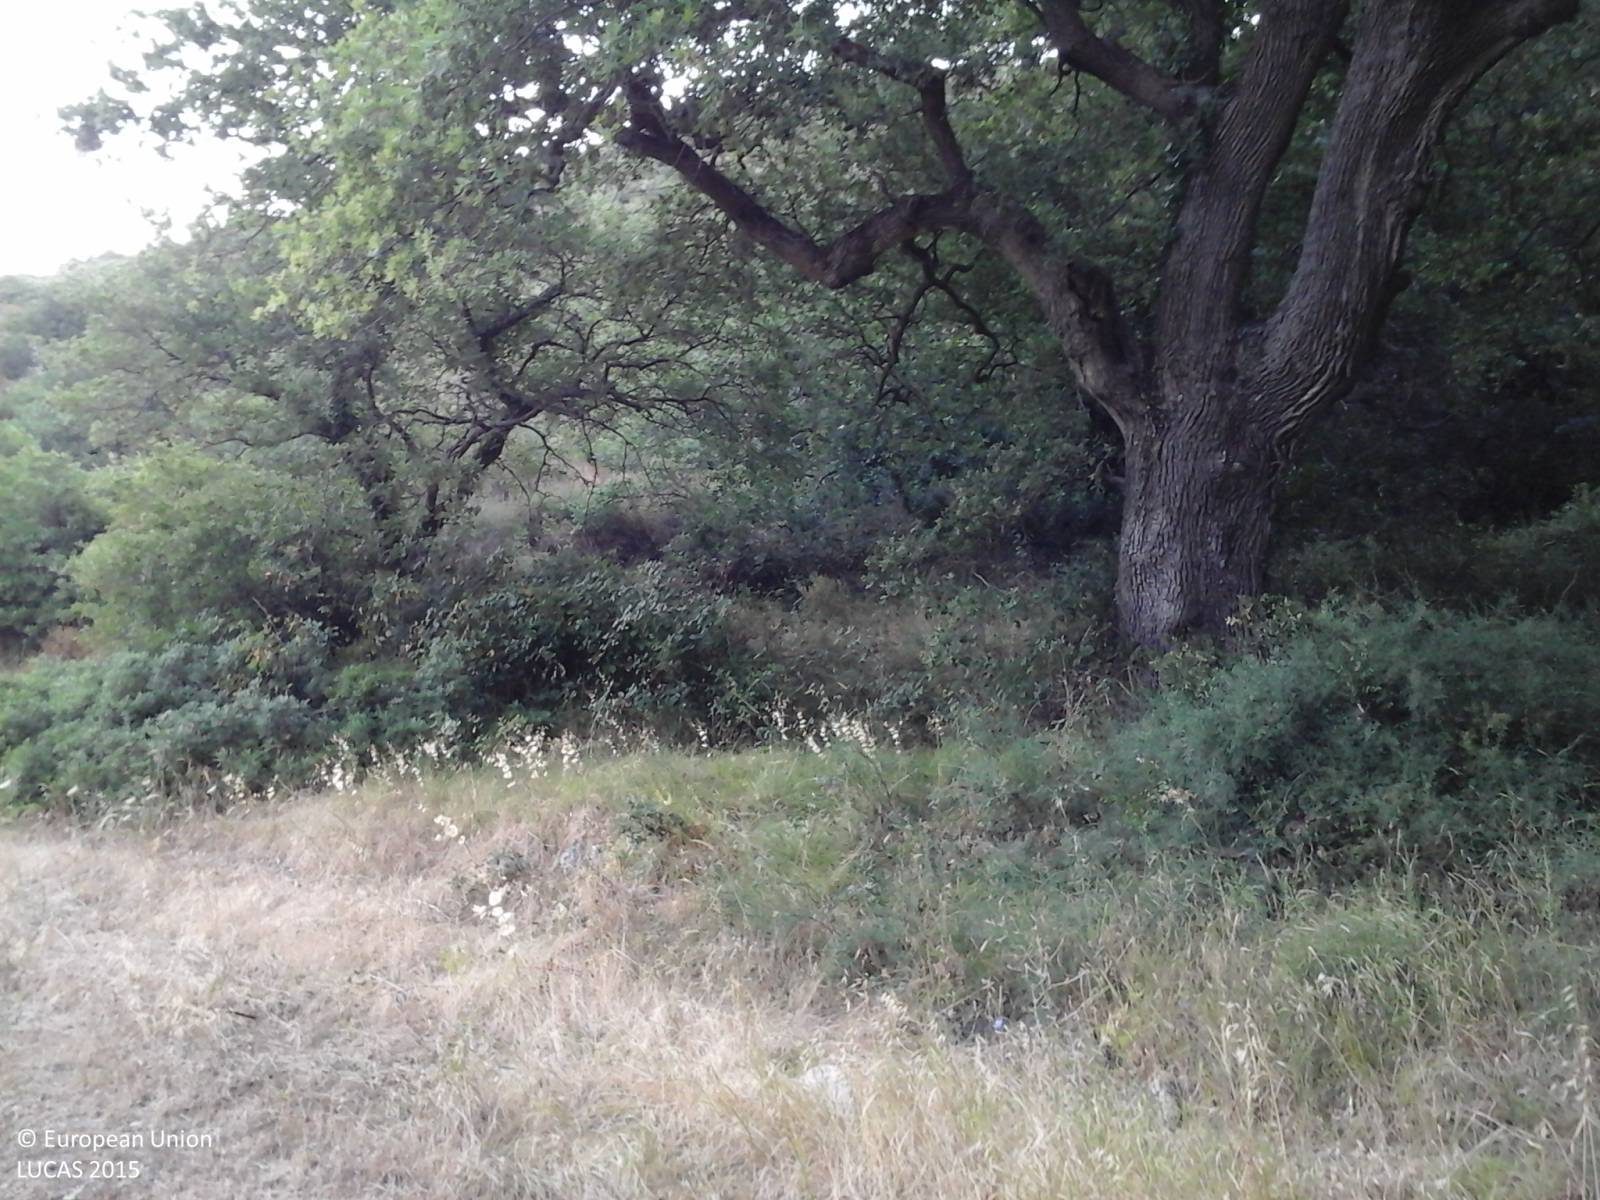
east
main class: Grassland
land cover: Grassland without tree/shrub cover
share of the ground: 25 - 50 %
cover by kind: herbaceous plants 100 %
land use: Agriculture (excluding fallow land and kitchen gardens)
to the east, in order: Grassland without tree/shrub cover; Broadleaved woodland; Artificial constructions in urban areas
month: July
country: IT
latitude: 40.7488
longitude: 8.8095
